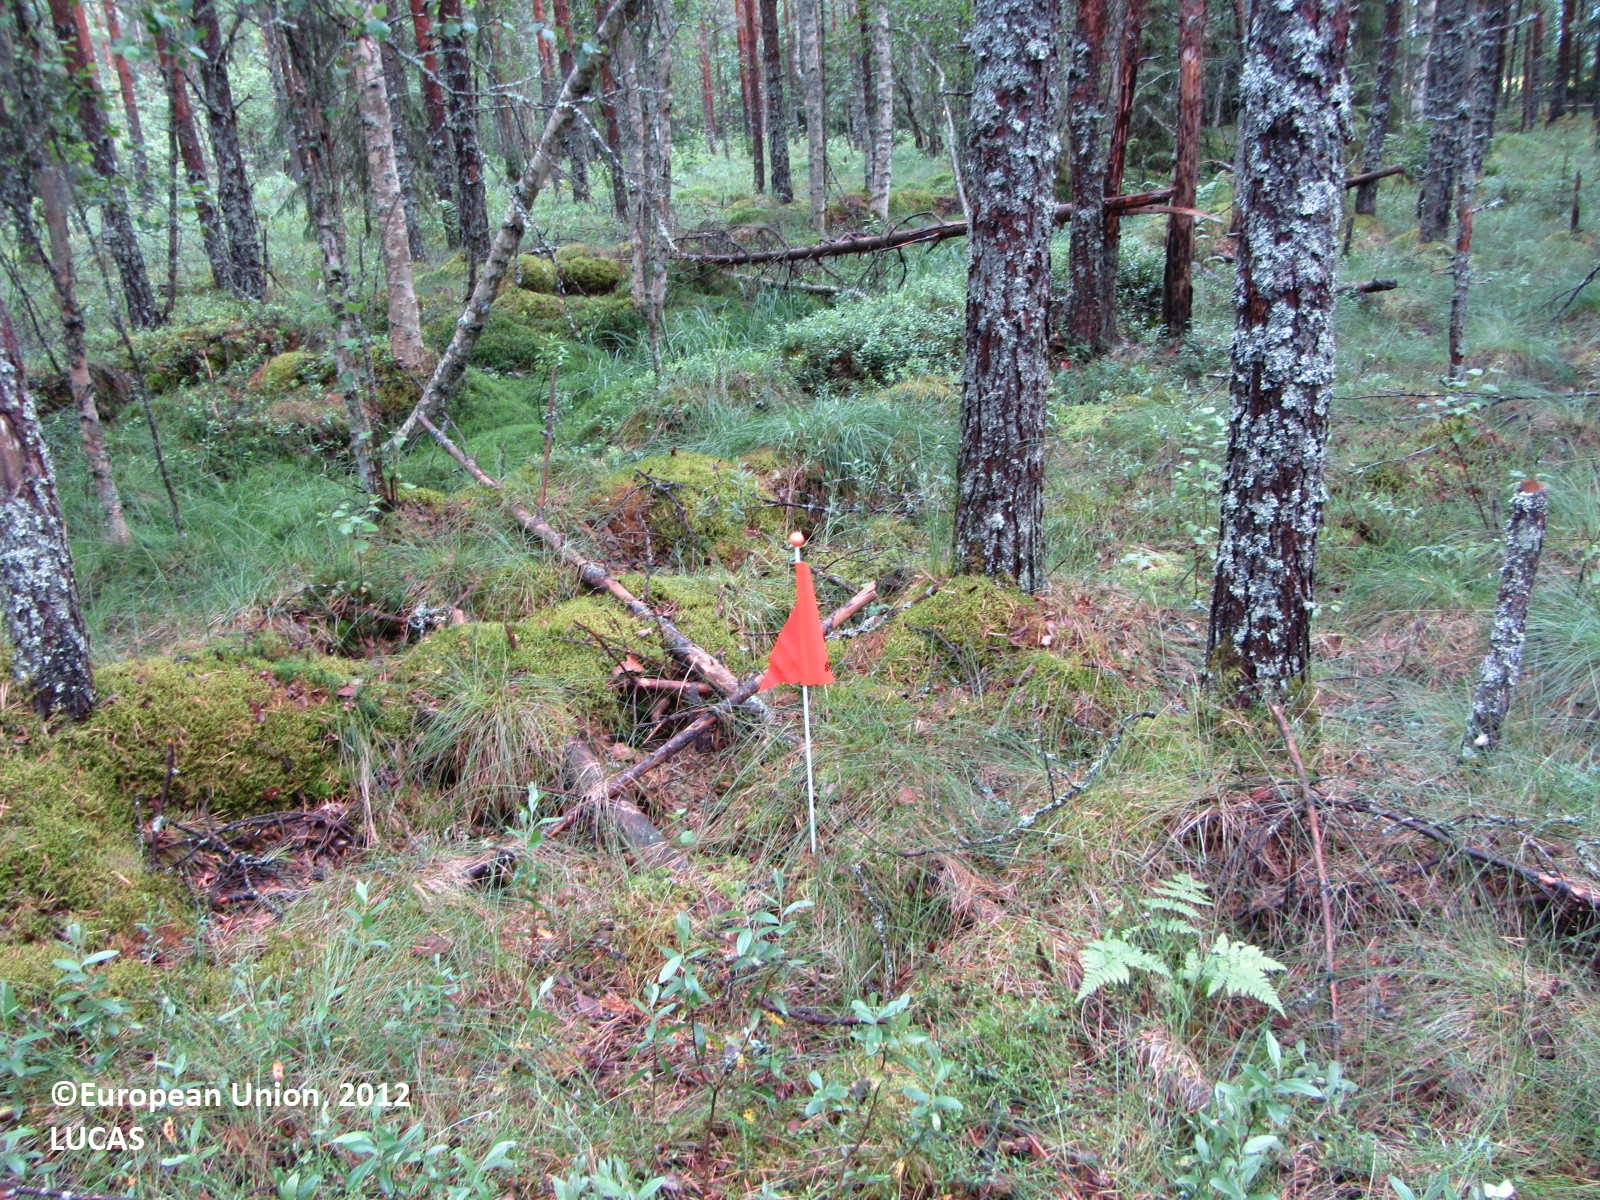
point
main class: Woodland
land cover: Pine dominated mixed woodland
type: boreal forest
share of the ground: > 75 %
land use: Forestry
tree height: > 5 m
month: July
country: FI
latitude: 63.8967
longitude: 25.6015
